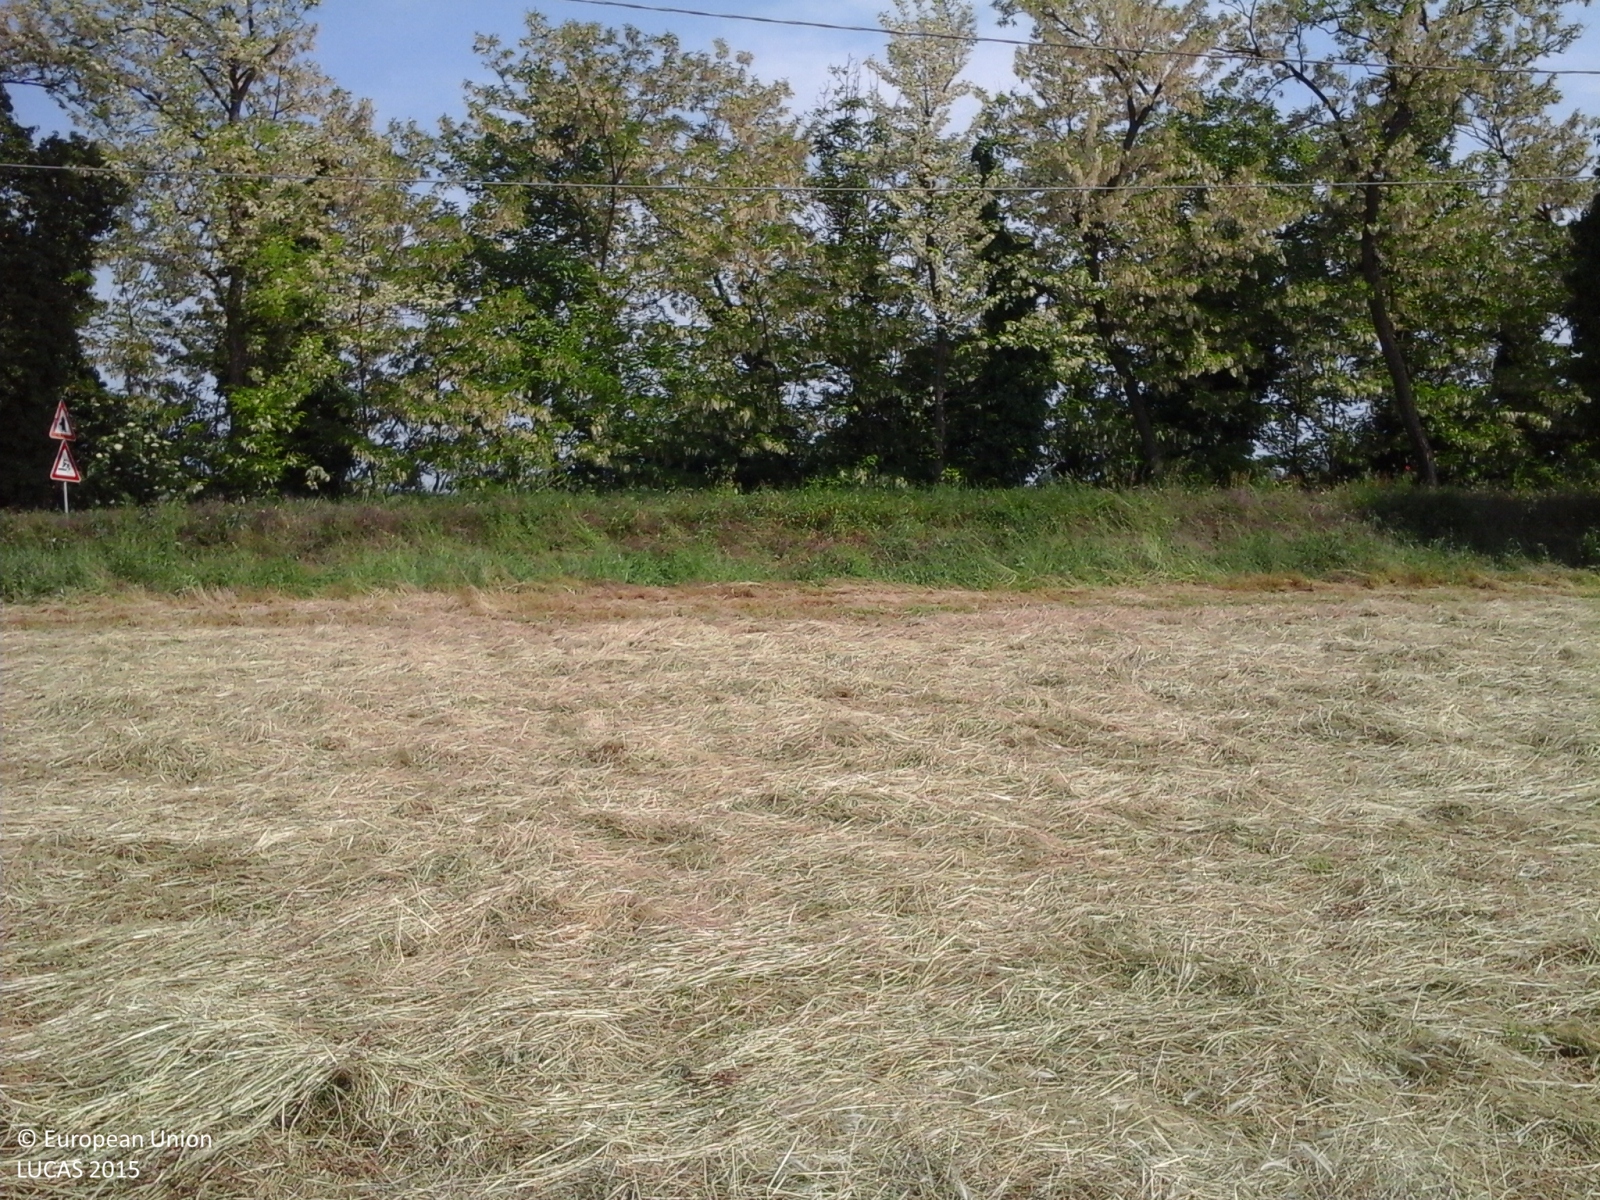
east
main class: Grassland
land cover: Spontaneously vegetated surfaces
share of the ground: > 75 %
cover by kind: herbaceous plants 100 %
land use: Agriculture (excluding fallow land and kitchen gardens)
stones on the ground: < 10 %
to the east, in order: Spontaneously vegetated surfaces; Electric lines; Ditches and canals; Grass margins; Paved roads, cycling and walking lanes; Lines of trees; Ditches and canals; Lines of trees; Tracks; Mixed cereals for fodder; Electric lines; Mixed cereals for fodder
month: May
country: IT
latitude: 44.6004
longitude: 10.7417
